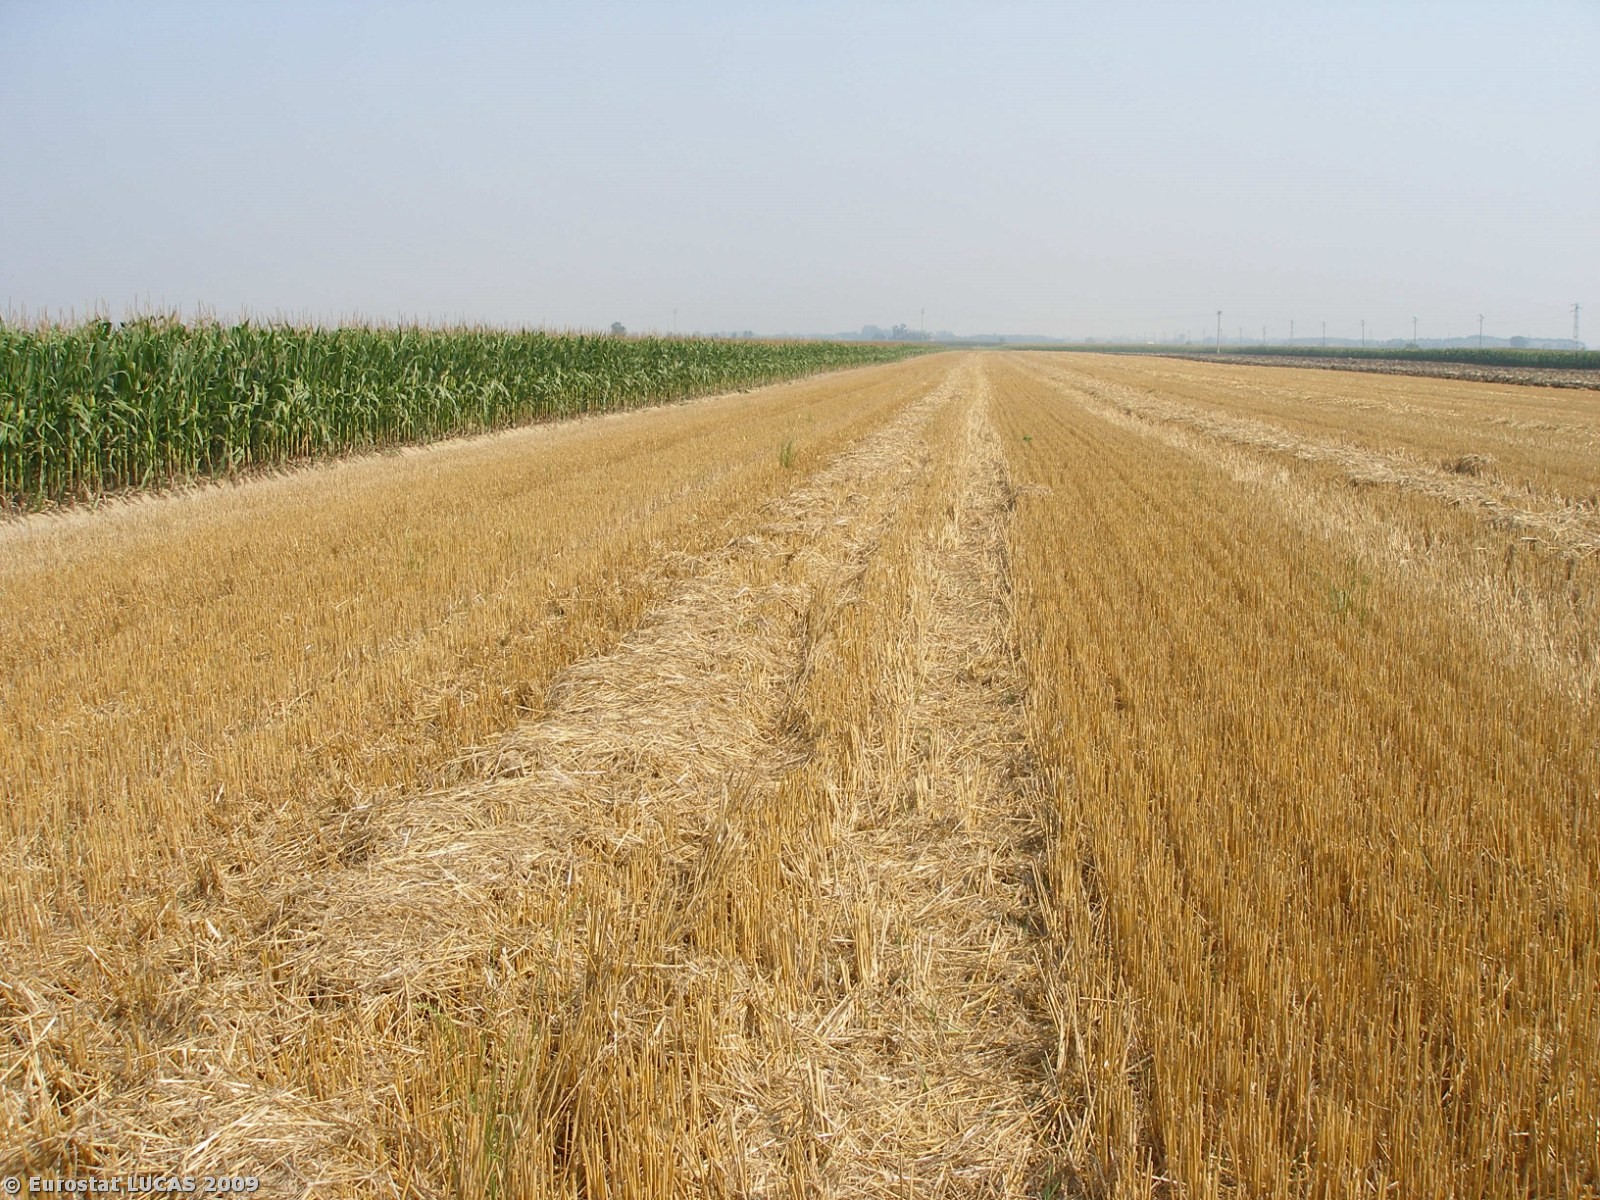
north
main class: Cropland
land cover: Common wheat
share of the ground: < 10 %
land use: Agriculture (excluding fallow land and kitchen gardens)
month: July
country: IT
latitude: 44.9673
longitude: 11.7337
